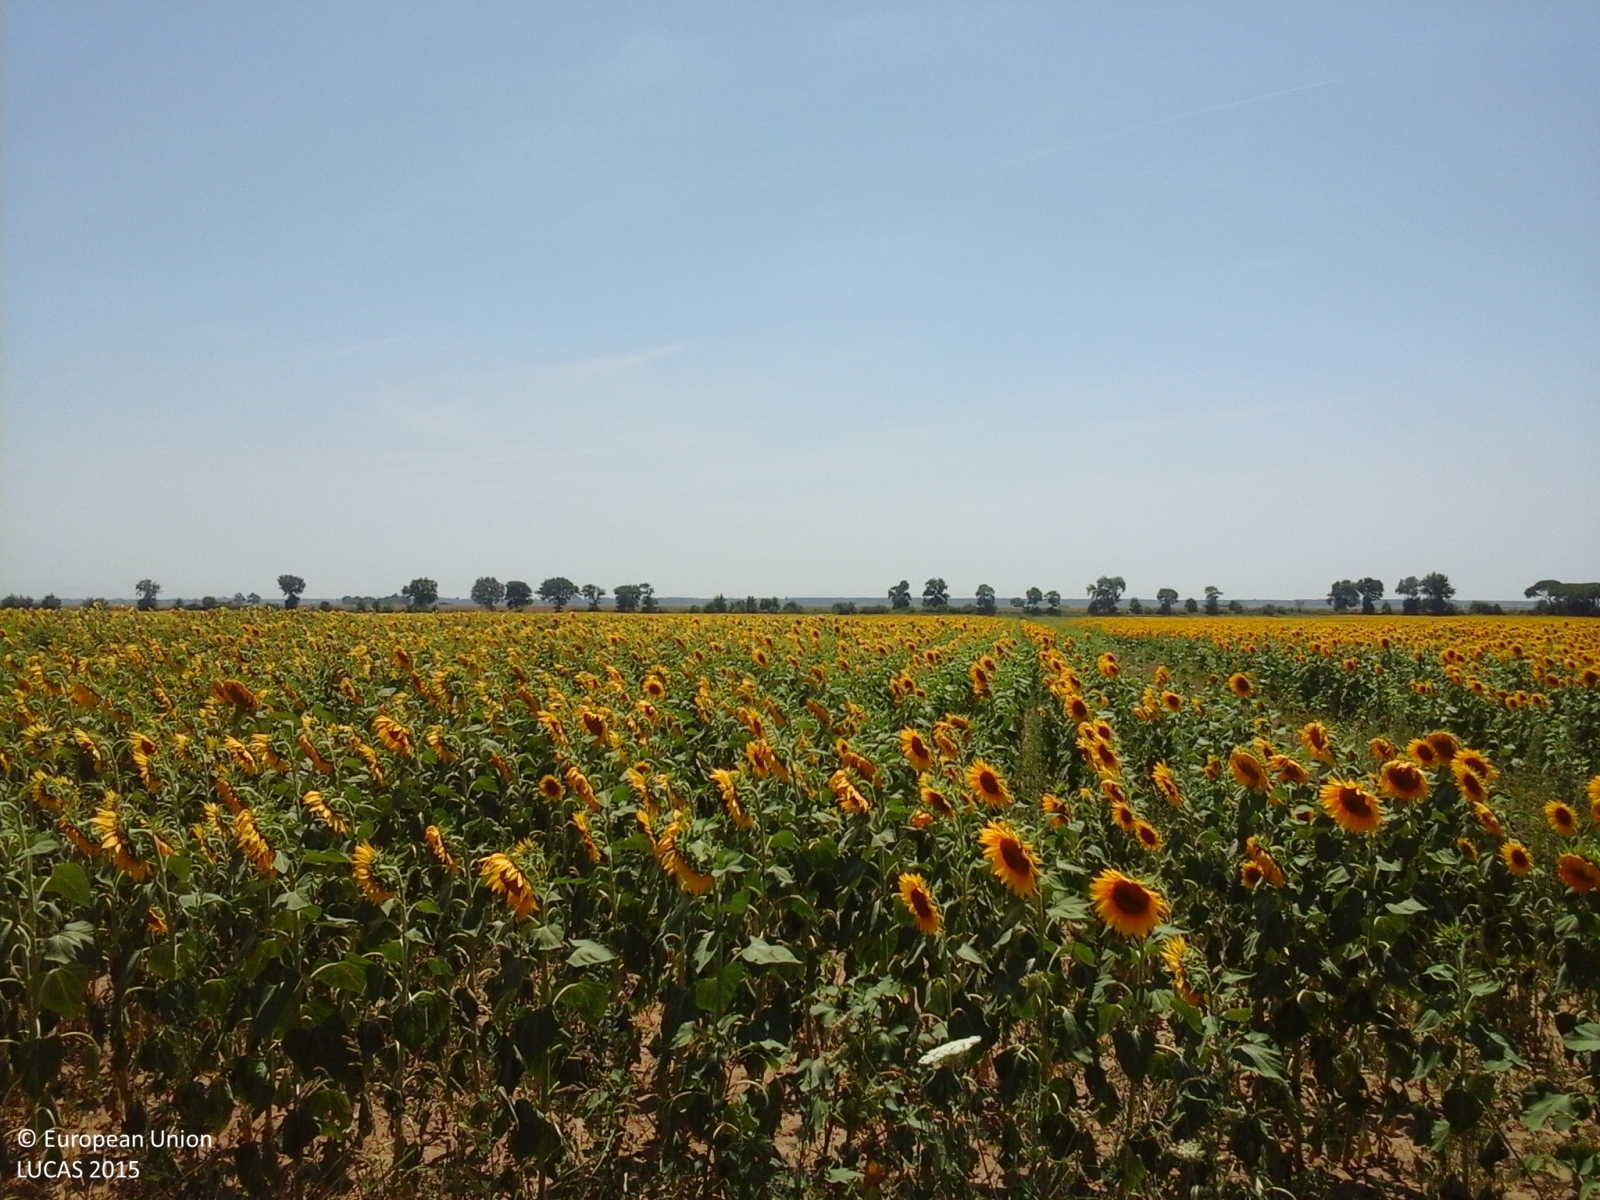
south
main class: Cropland
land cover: Sunflower
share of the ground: > 75 %
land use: Agriculture (excluding fallow land and kitchen gardens)
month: June
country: IT
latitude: 42.7939
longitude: 10.9627
